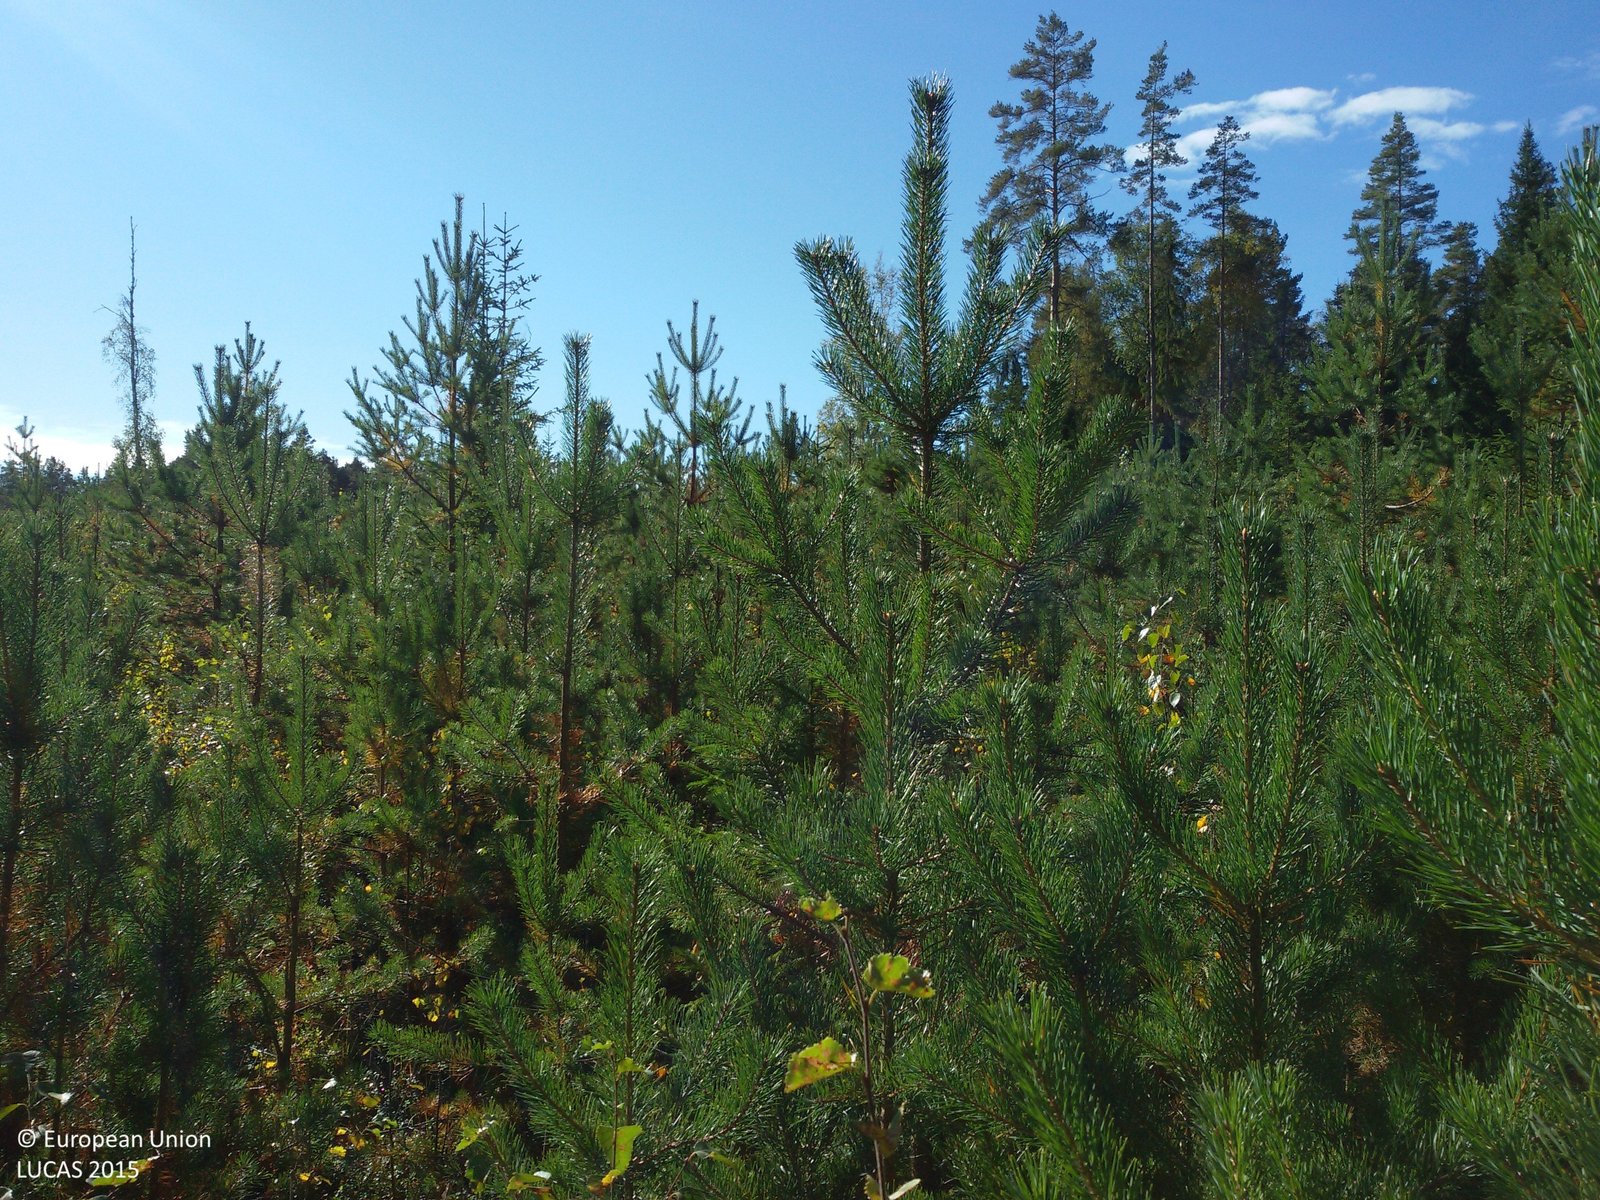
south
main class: Woodland
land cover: Pine dominated coniferous woodland
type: boreal forest
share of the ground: > 75 %
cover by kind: coniferous forest trees 90 %, shrubs 10 %
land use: Forestry
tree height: < 5 m
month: September
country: SE
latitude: 60.7721
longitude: 14.6322
